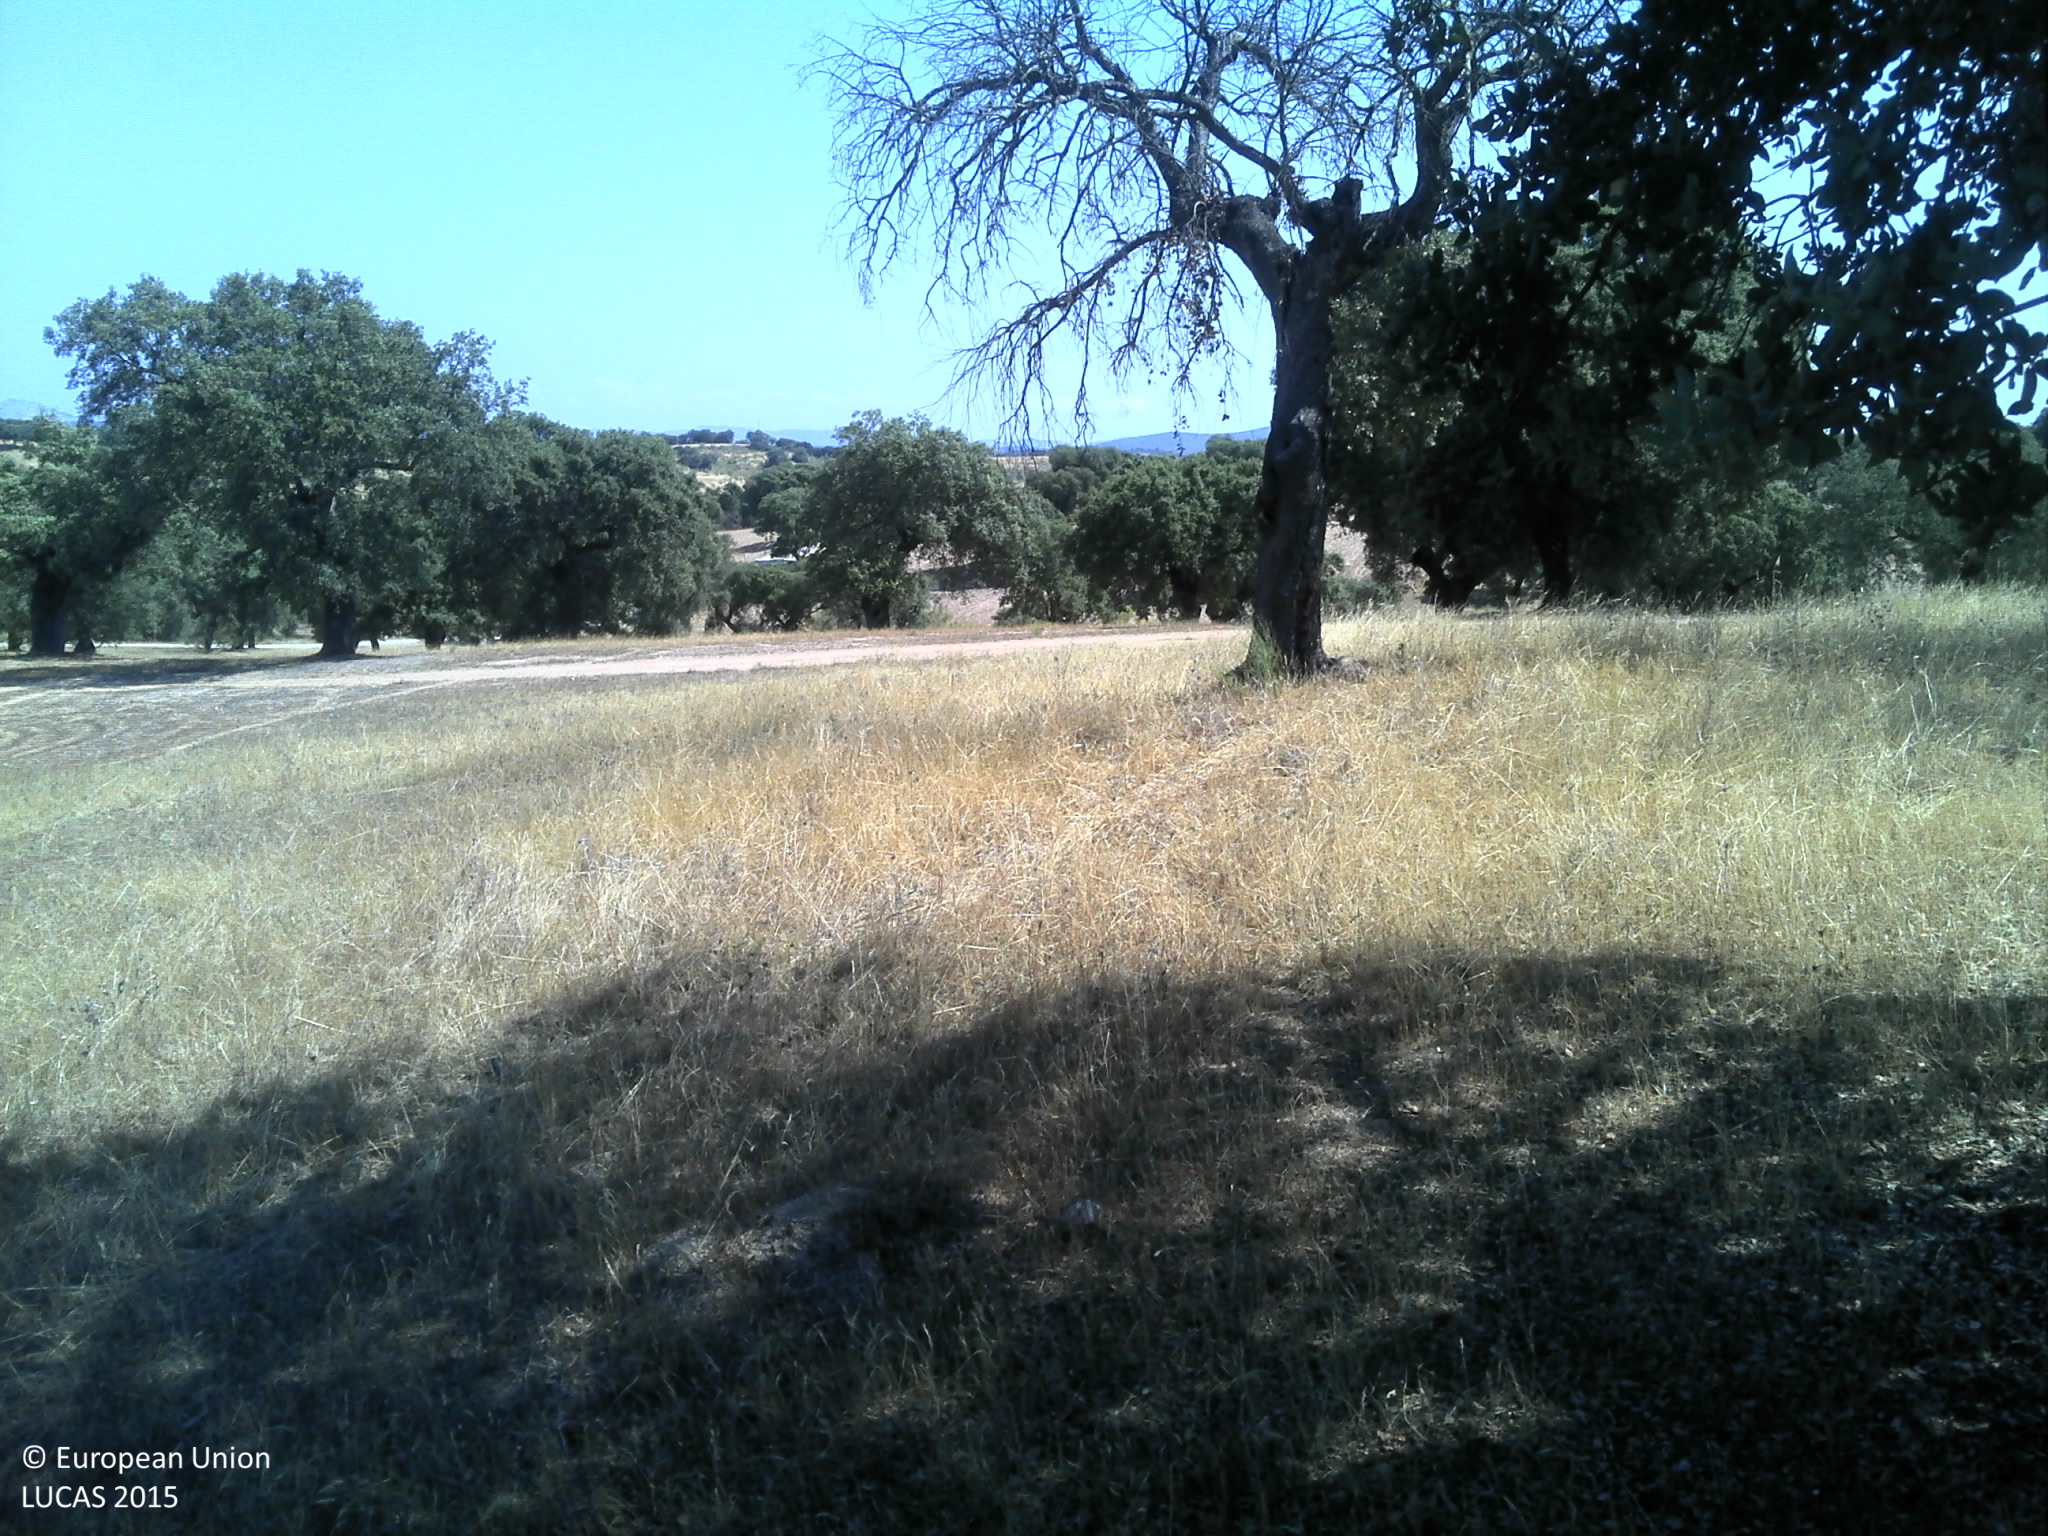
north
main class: Woodland
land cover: Broadleaved woodland
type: broadleaved evergreen forest
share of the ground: 25 - 50 %
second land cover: Spontaneously vegetated surfaces
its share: 25 - 50 %
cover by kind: broadleaved forest trees 40 %, herbaceous plants 30 %, unconsolidated bare surface 25 %
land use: Forestry
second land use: Agriculture (excluding fallow land and kitchen gardens)
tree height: > 5 m
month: June
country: PT
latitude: 39.8820
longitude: -7.0805
